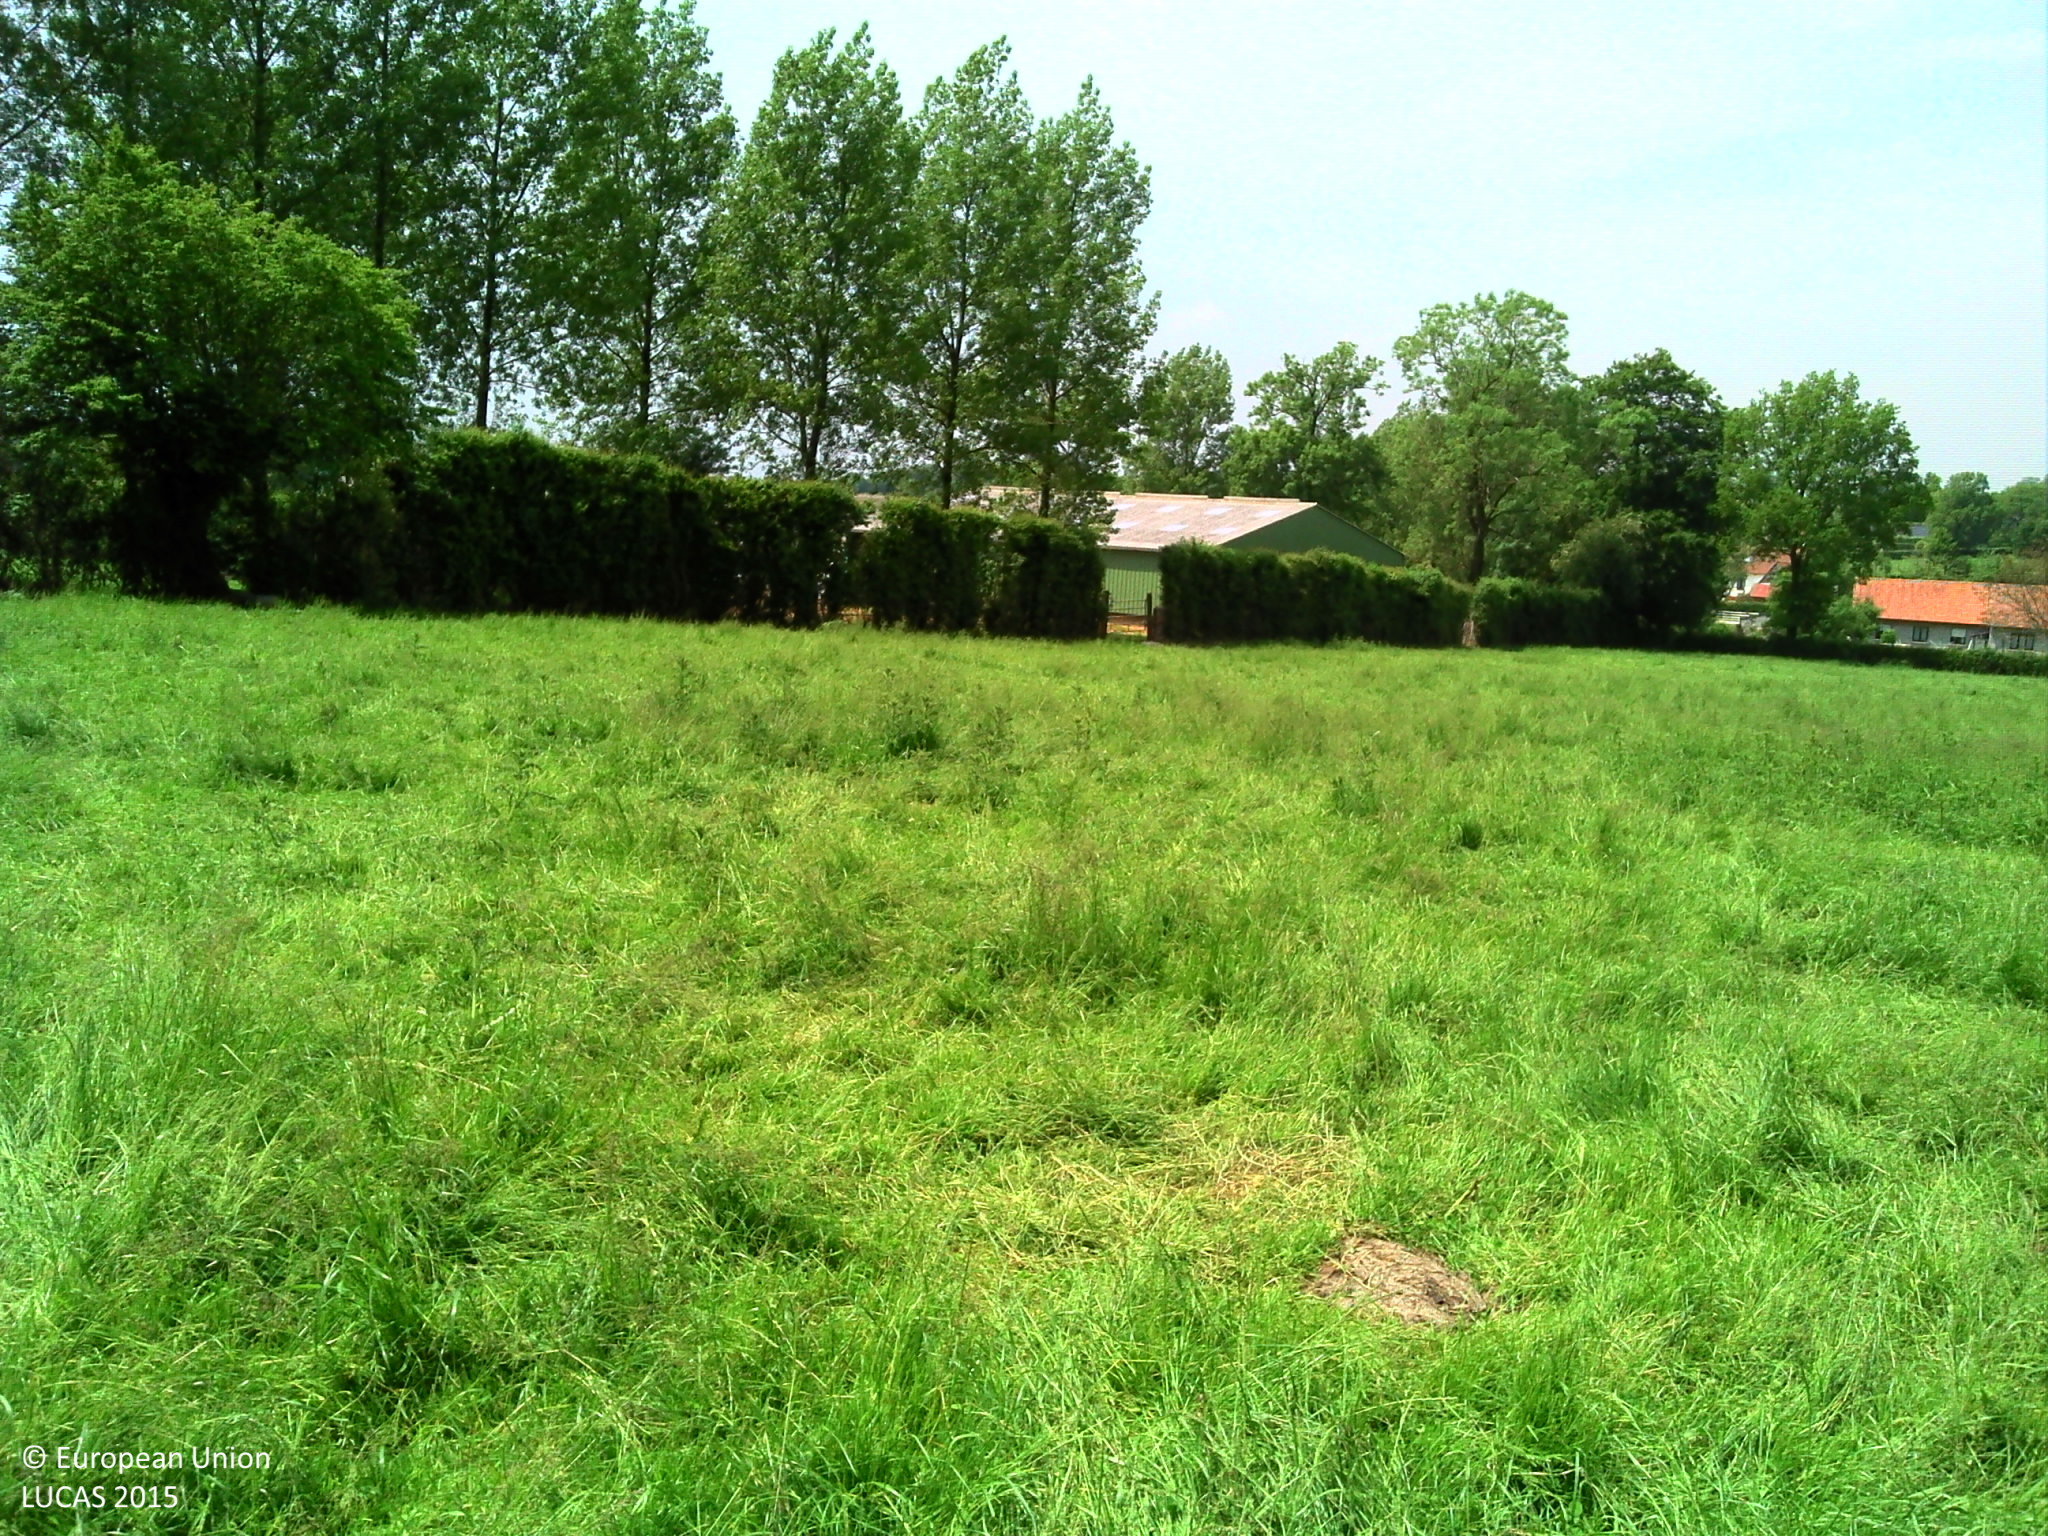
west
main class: Grassland
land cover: Grassland without tree/shrub cover
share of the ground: > 75 %
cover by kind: herbaceous plants 100 %
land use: Agriculture (excluding fallow land and kitchen gardens)
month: June
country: FR
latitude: 50.6313
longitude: 2.0818
